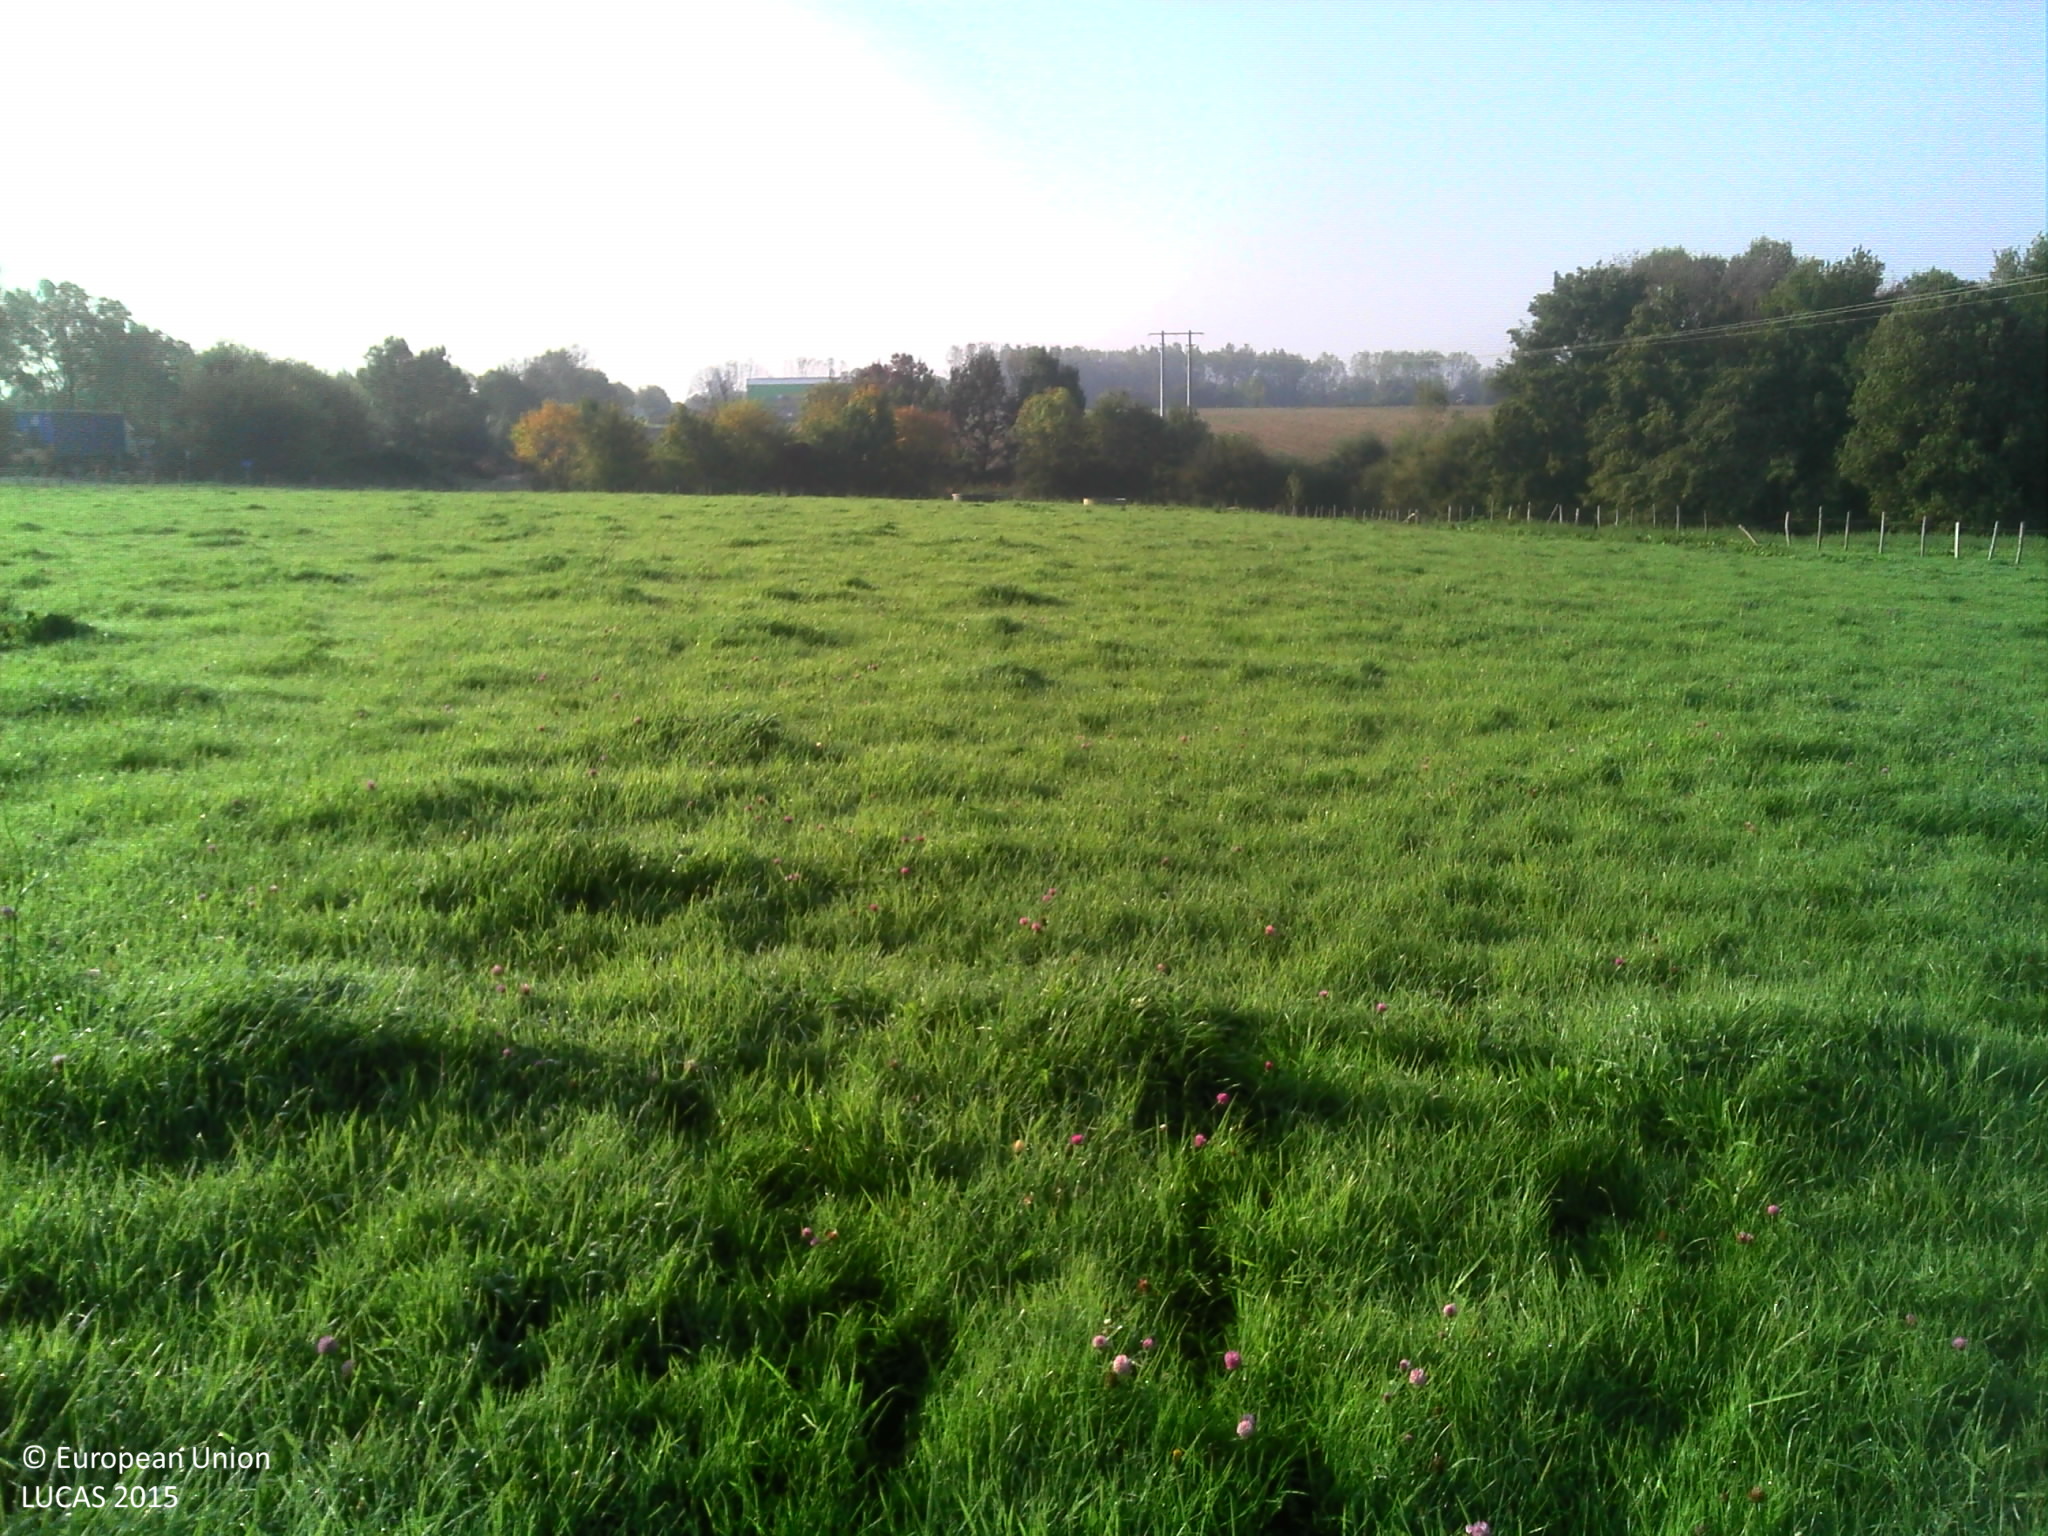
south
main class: Grassland
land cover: Grassland without tree/shrub cover
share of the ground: > 75 %
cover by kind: herbaceous plants 100 %
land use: Agriculture (excluding fallow land and kitchen gardens)
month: October
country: FR
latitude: 46.6137
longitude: -1.0403
